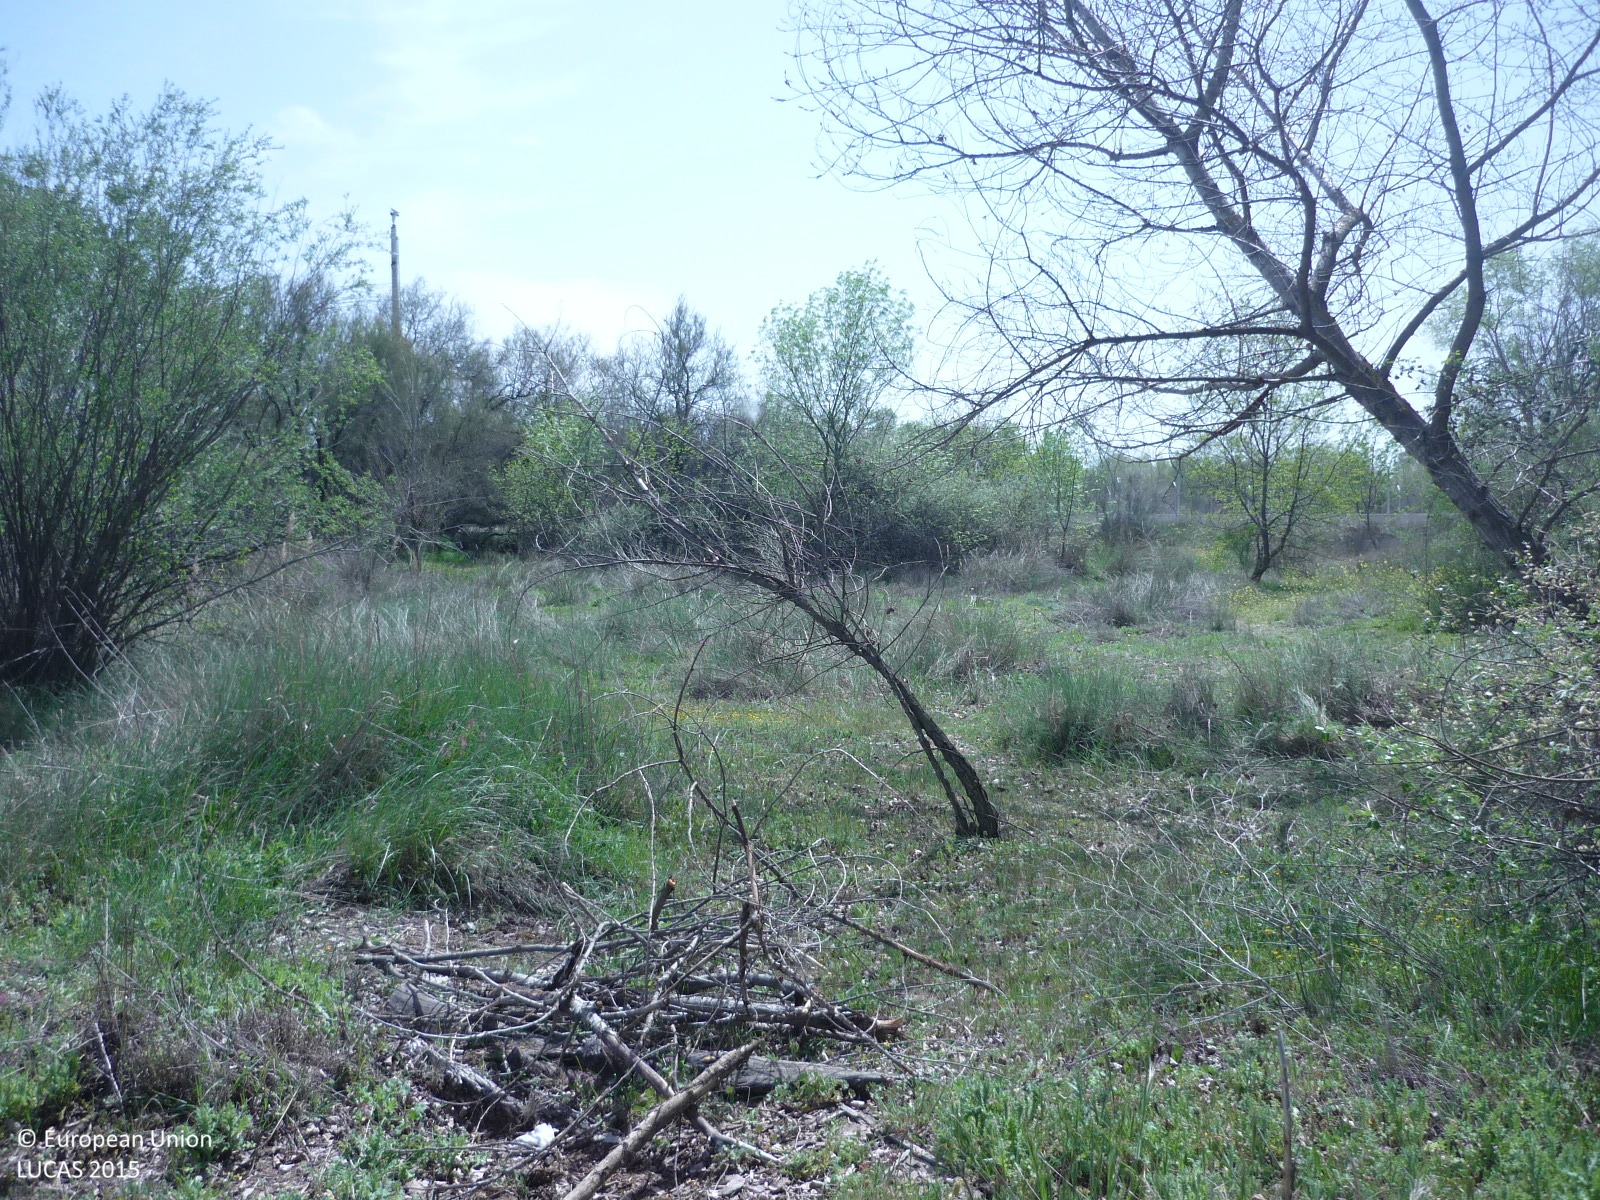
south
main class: Woodland
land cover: Broadleaved woodland
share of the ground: > 75 %
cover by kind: broadleaved forest trees 80 %, herbaceous plants 15 %, consolidated bare surface 5 %
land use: Semi-natural and natural areas not in use
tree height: > 5 m
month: April
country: ES
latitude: 40.4933
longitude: -3.4263
